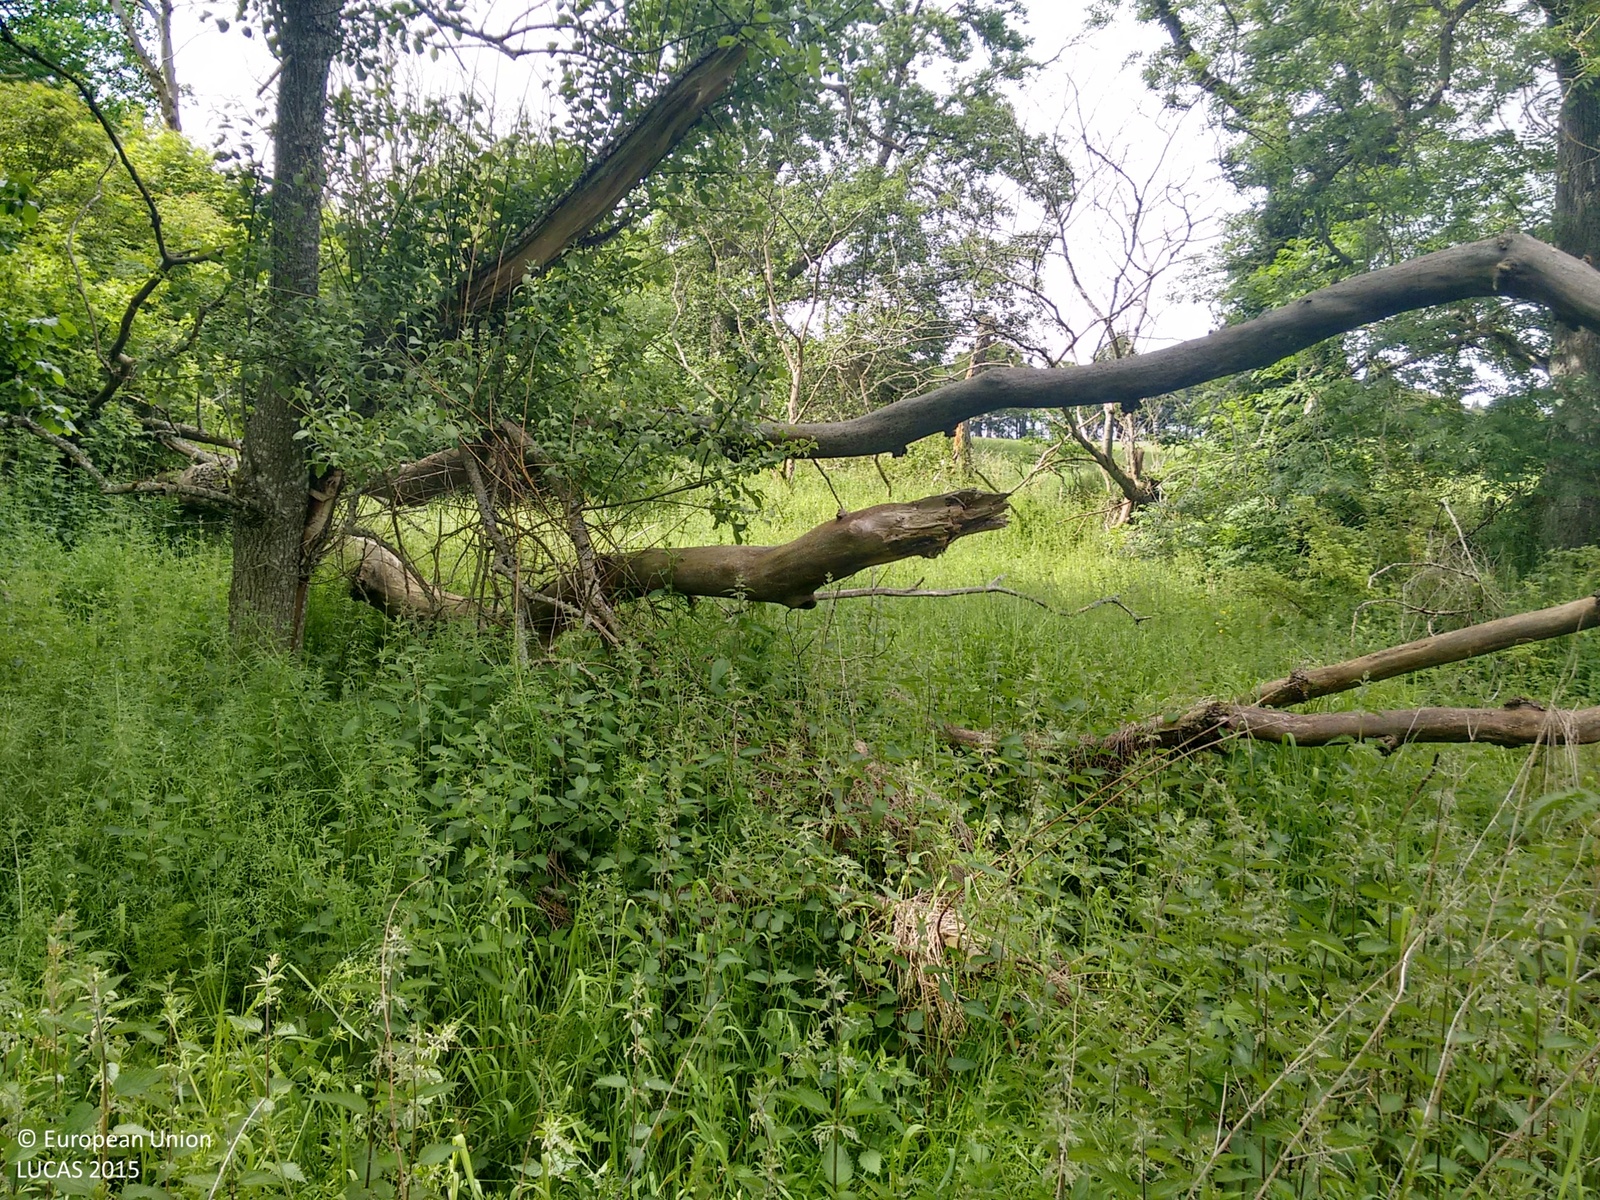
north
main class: Woodland
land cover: Broadleaved woodland
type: exotic forest
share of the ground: > 75 %
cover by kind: broadleaved forest trees 75 %, herbaceous plants 25 %
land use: Semi-natural and natural areas not in use
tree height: > 5 m
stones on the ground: < 10 %
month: June
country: GB
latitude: 57.1750
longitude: -2.7112
